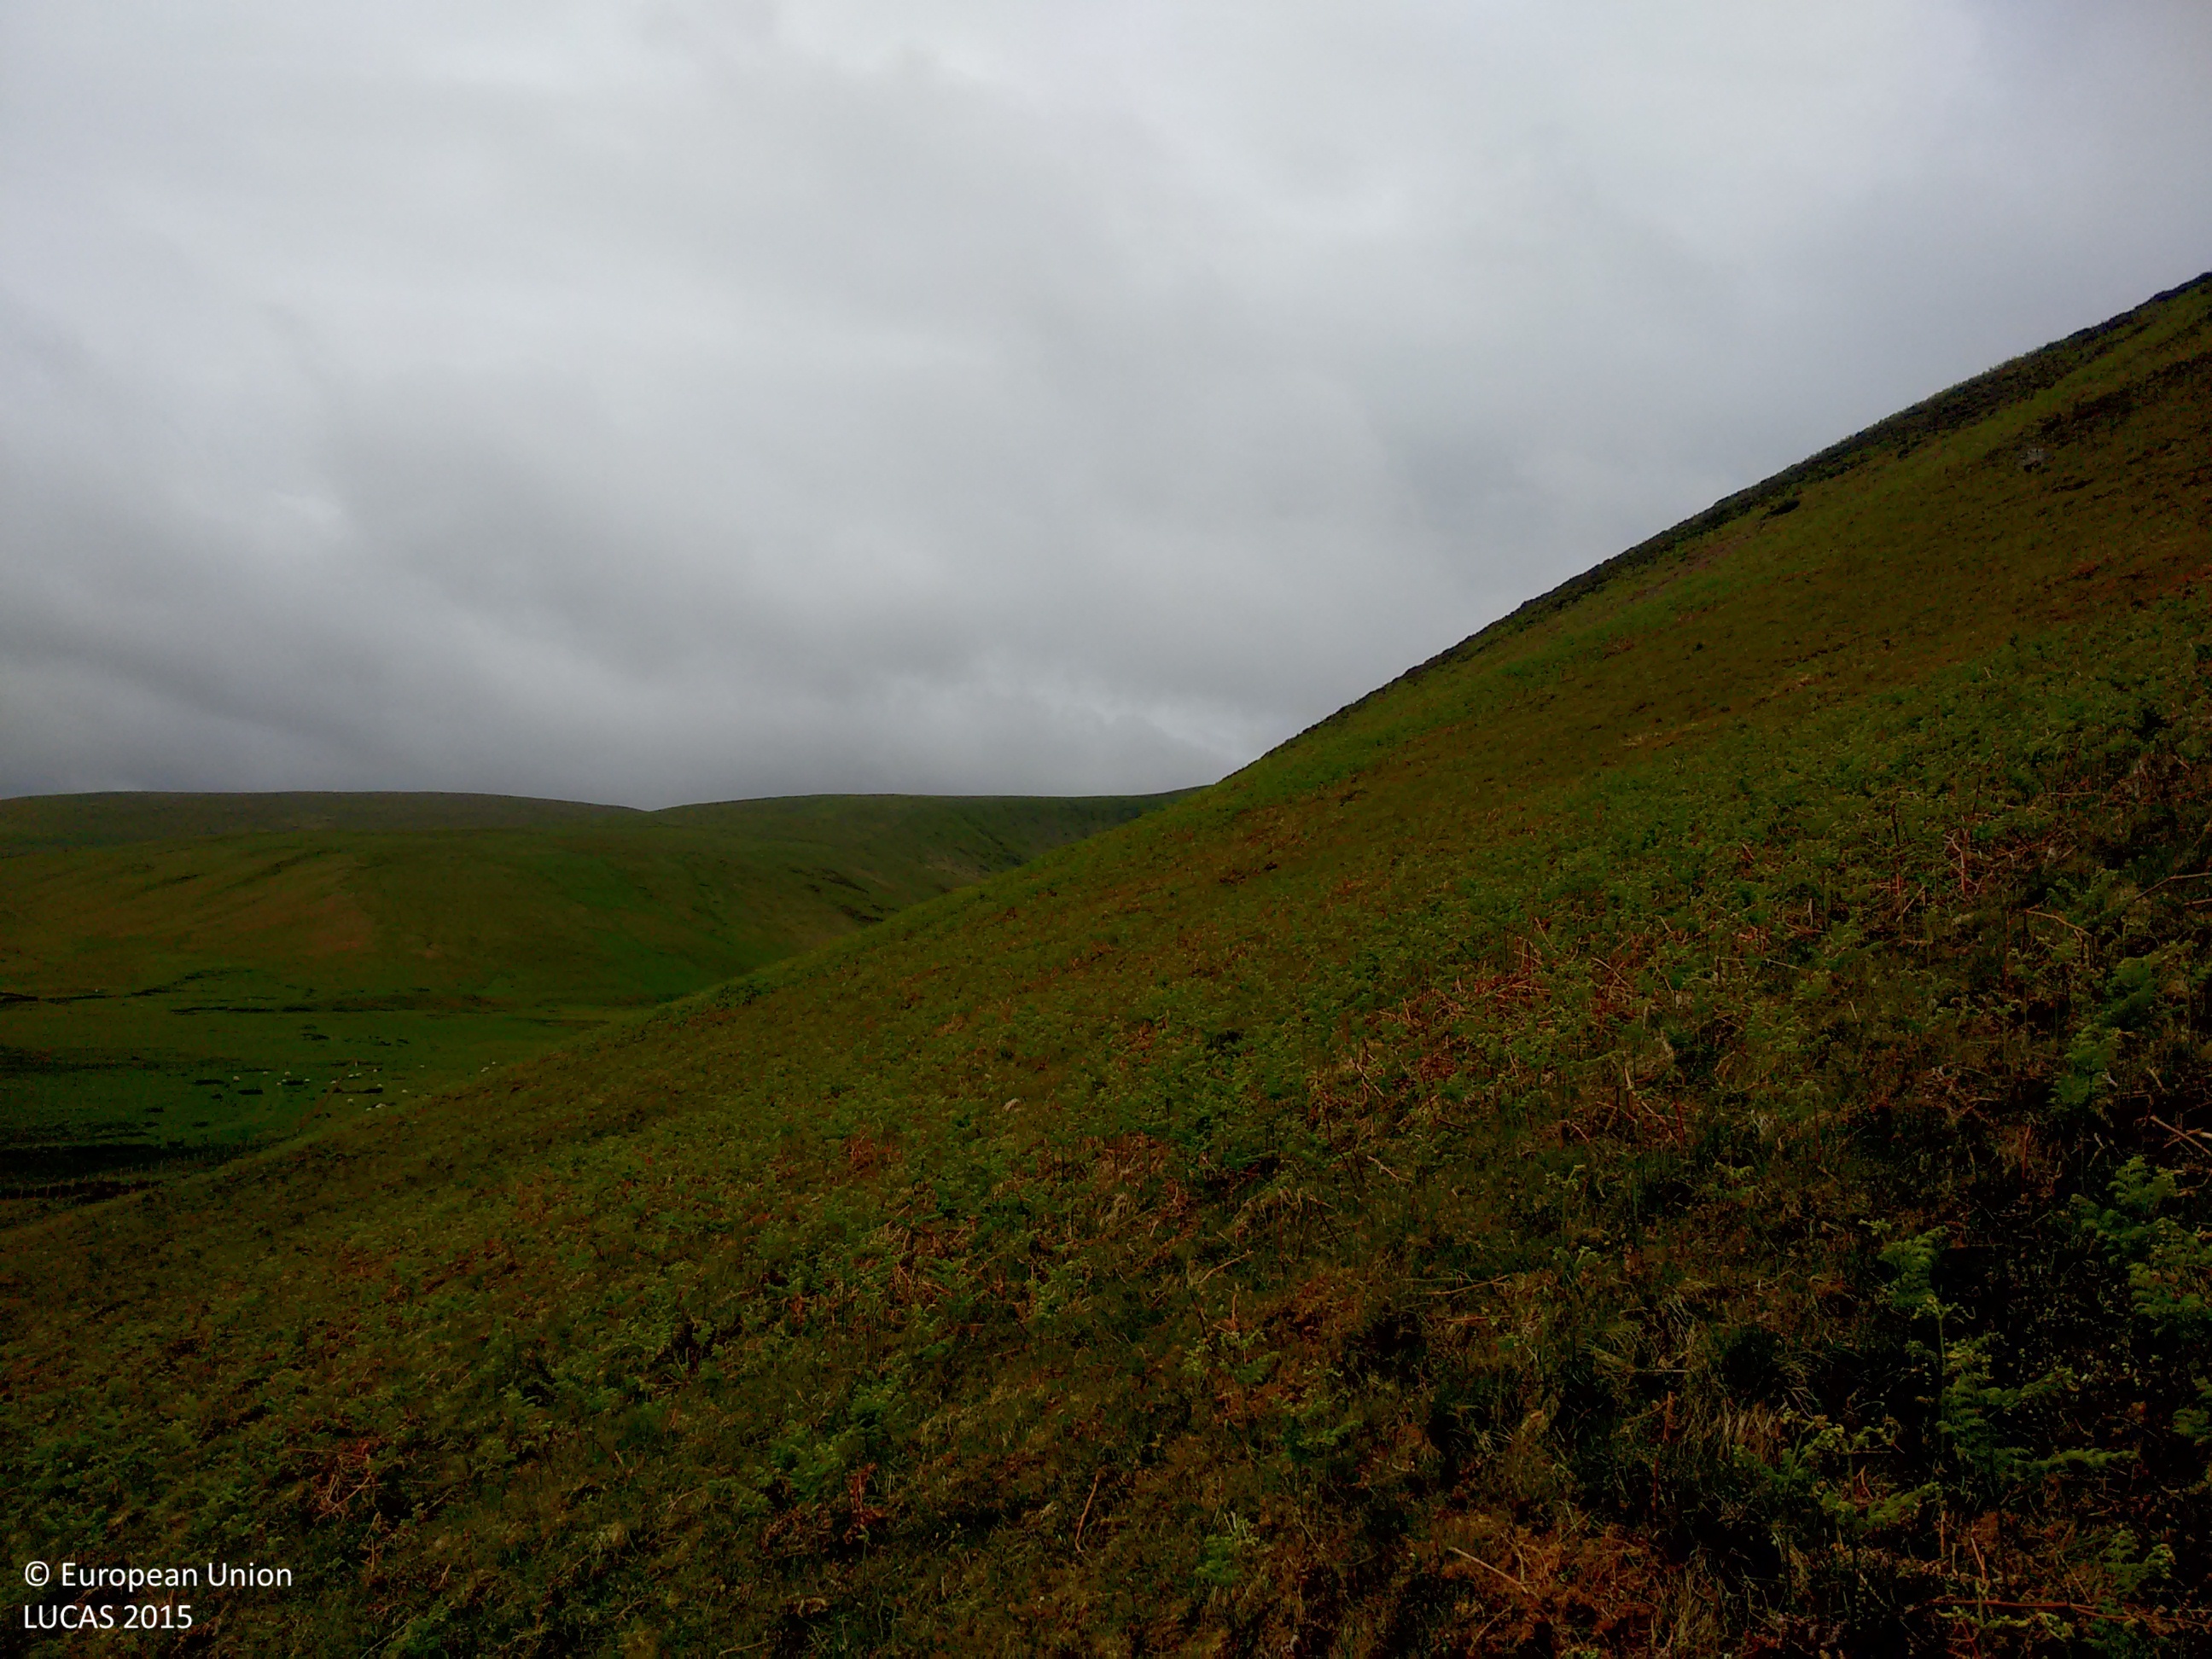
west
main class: Grassland
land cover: Grassland without tree/shrub cover
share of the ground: > 75 %
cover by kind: herbaceous plants 100 %
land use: Agriculture (excluding fallow land and kitchen gardens)
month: June
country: GB
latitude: 55.5461
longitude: -3.4709
